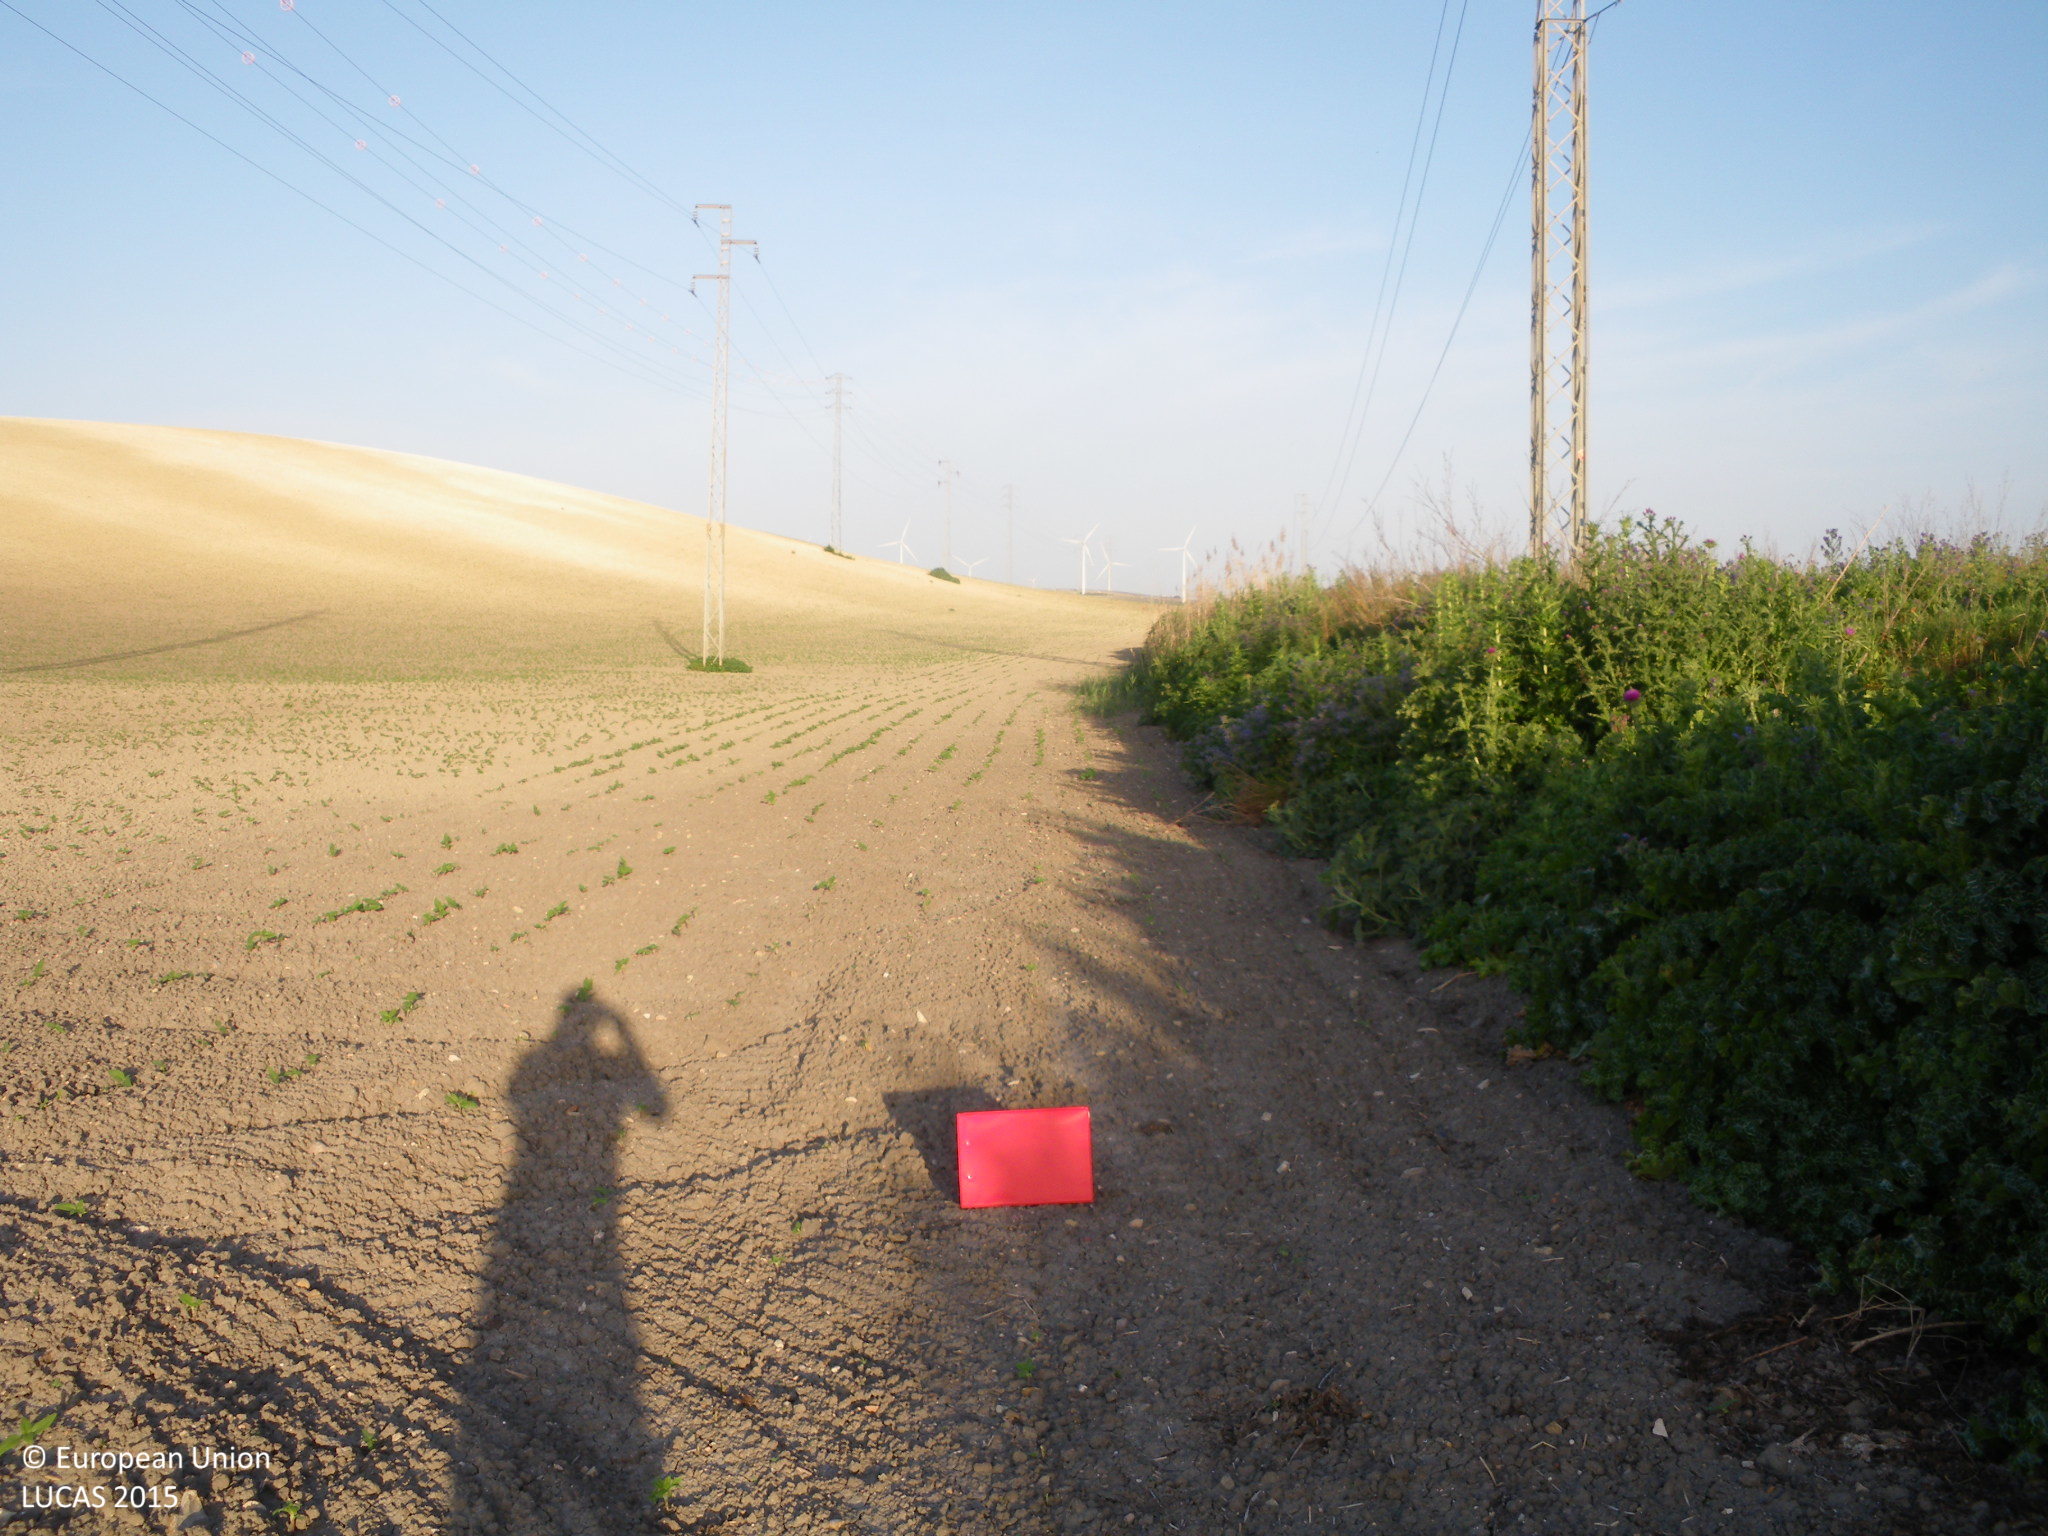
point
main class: Cropland
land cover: Sunflower
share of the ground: < 10 %
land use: Agriculture (excluding fallow land and kitchen gardens)
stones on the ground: < 10 %
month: April
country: ES
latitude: 36.6835
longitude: -6.1837
